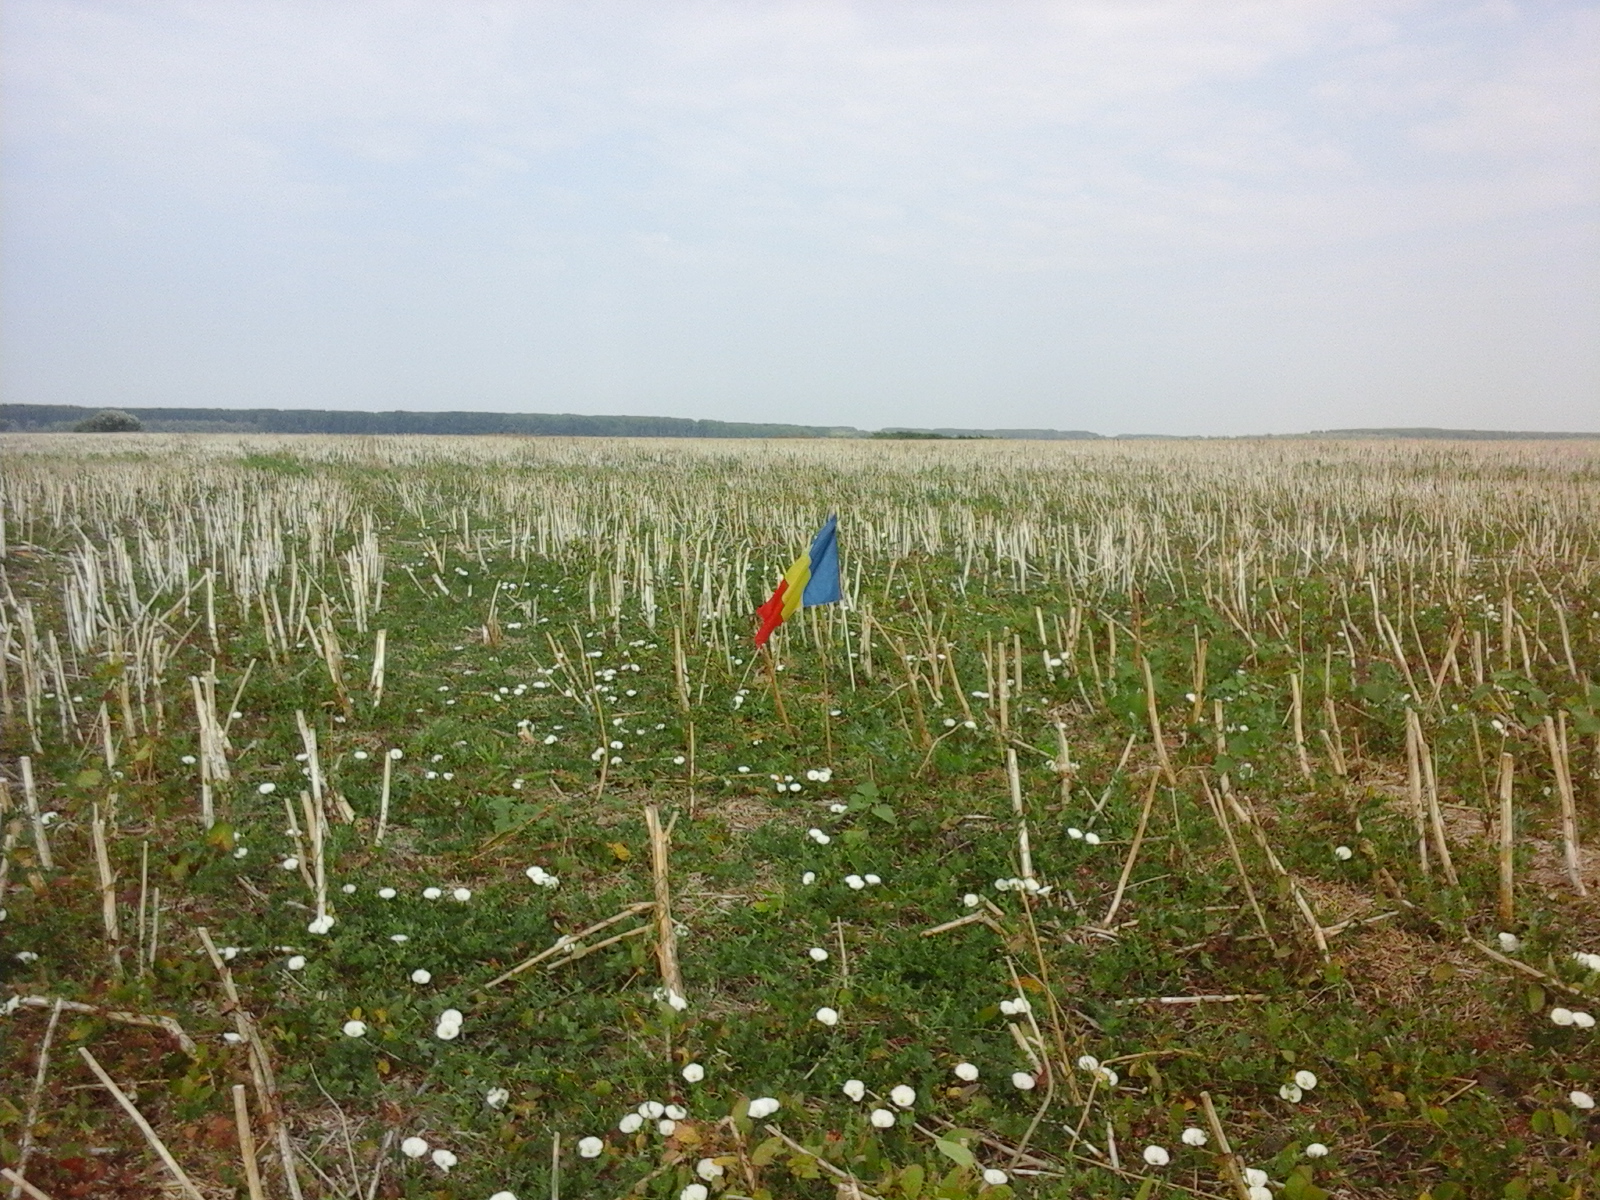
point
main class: Cropland
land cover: Rape and turnip rape
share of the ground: > 75 %
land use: Agriculture (excluding fallow land and kitchen gardens)
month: July
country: RO
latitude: 44.5024
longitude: 27.9536
